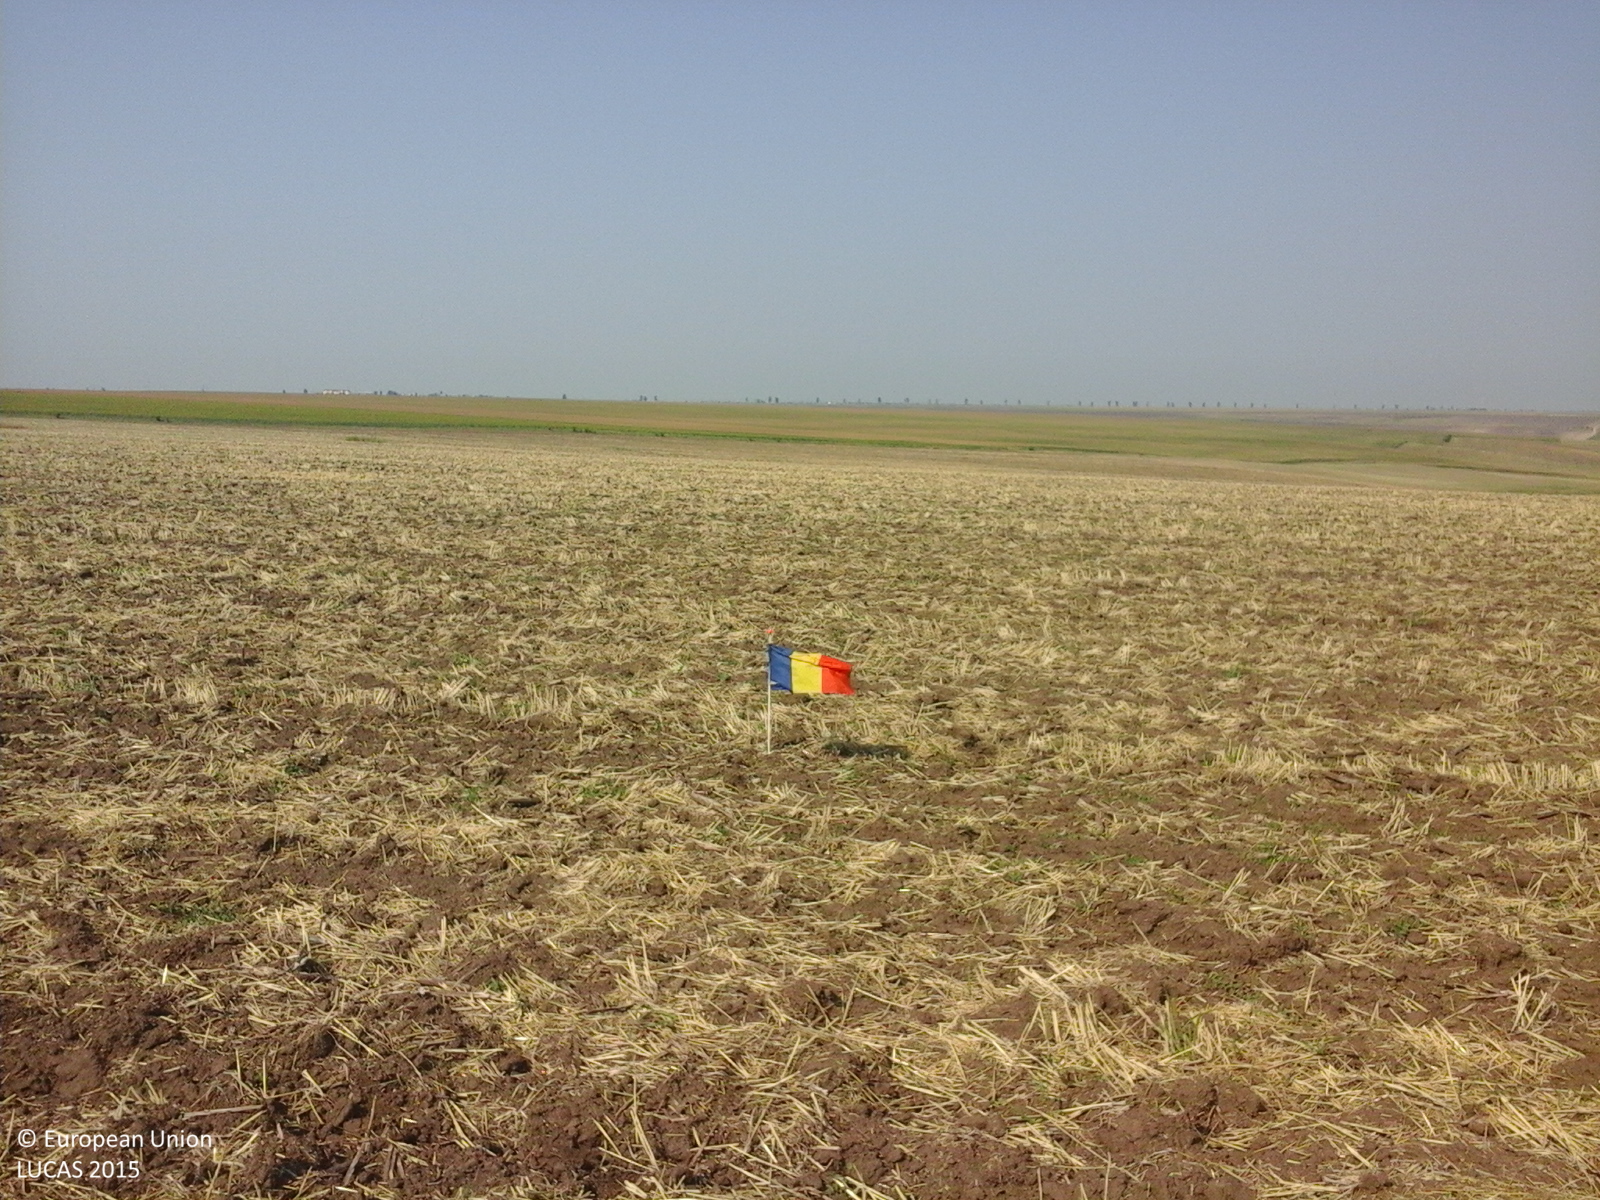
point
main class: Cropland
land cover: Common wheat
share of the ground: 25 - 50 %
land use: Agriculture (excluding fallow land and kitchen gardens)
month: July
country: RO
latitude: 45.5693
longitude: 27.8605
